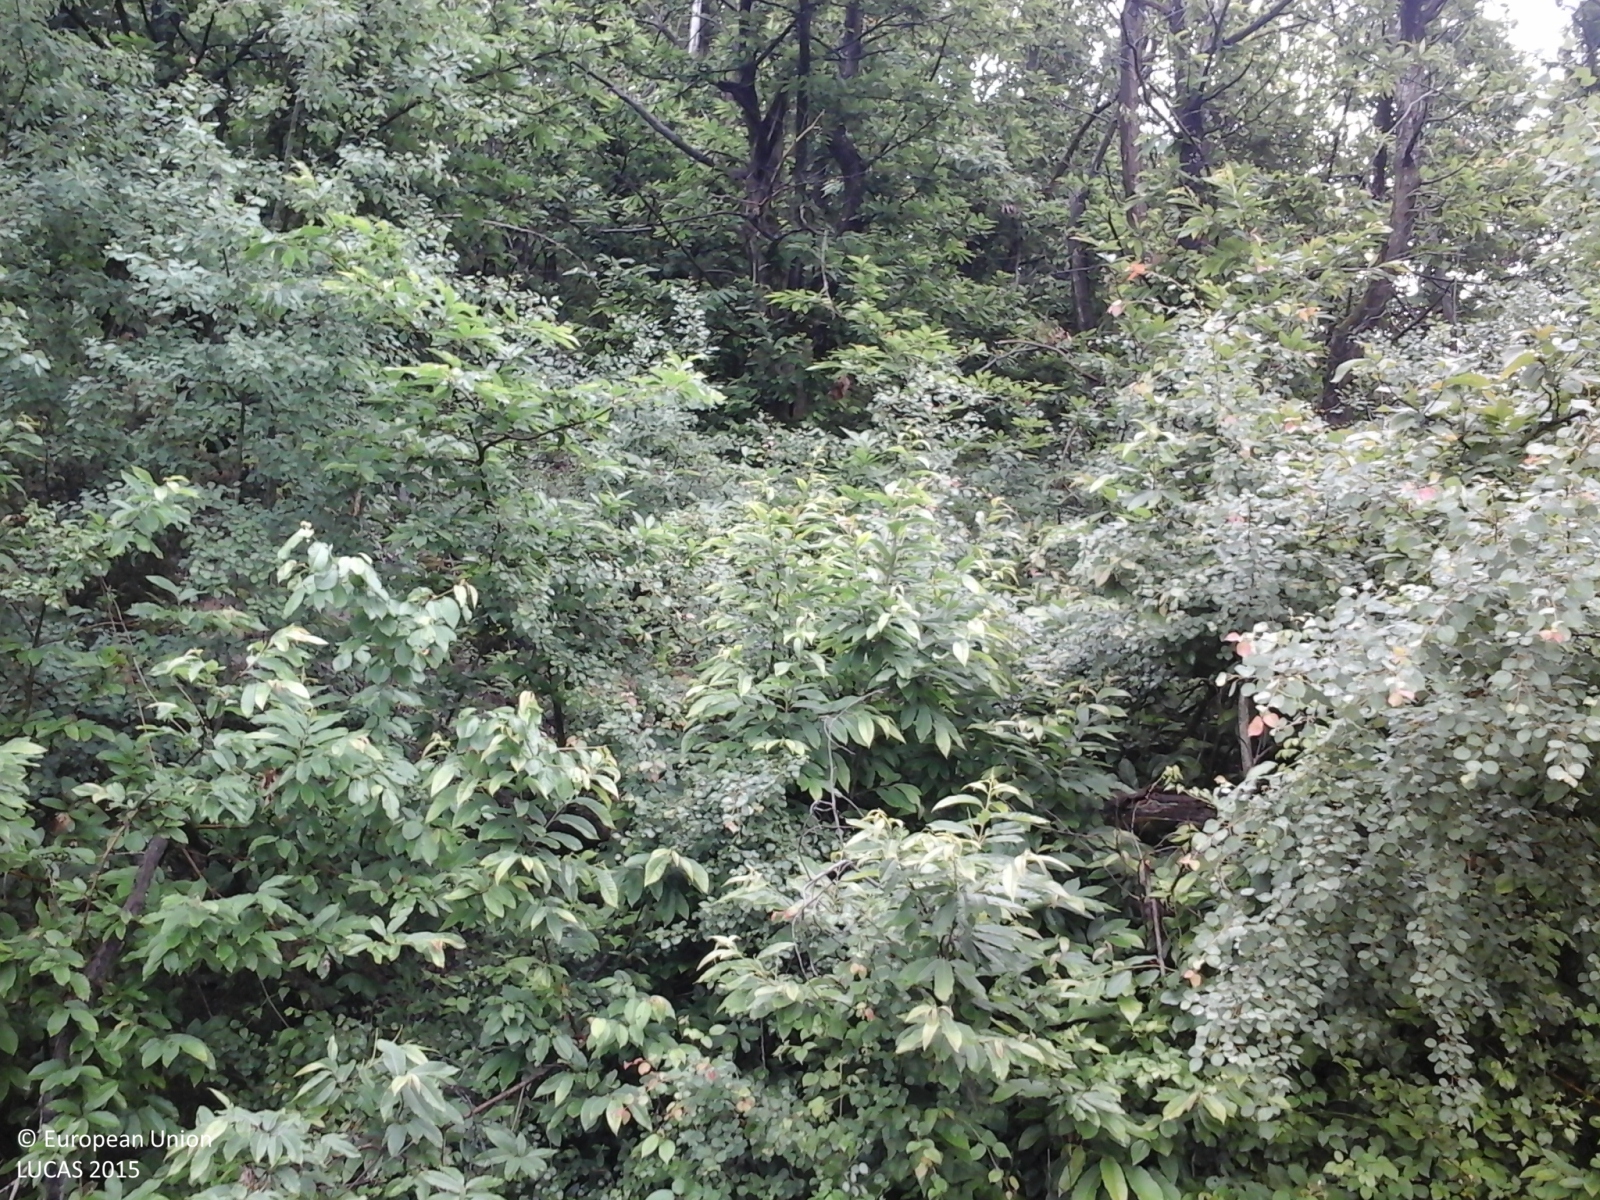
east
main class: Woodland
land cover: Broadleaved woodland
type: thermophilous deciduous forest
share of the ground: > 75 %
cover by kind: broadleaved forest trees 100 %
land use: Forestry
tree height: > 5 m
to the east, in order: Broadleaved woodland
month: May
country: IT
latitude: 44.3077
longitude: 11.1882
